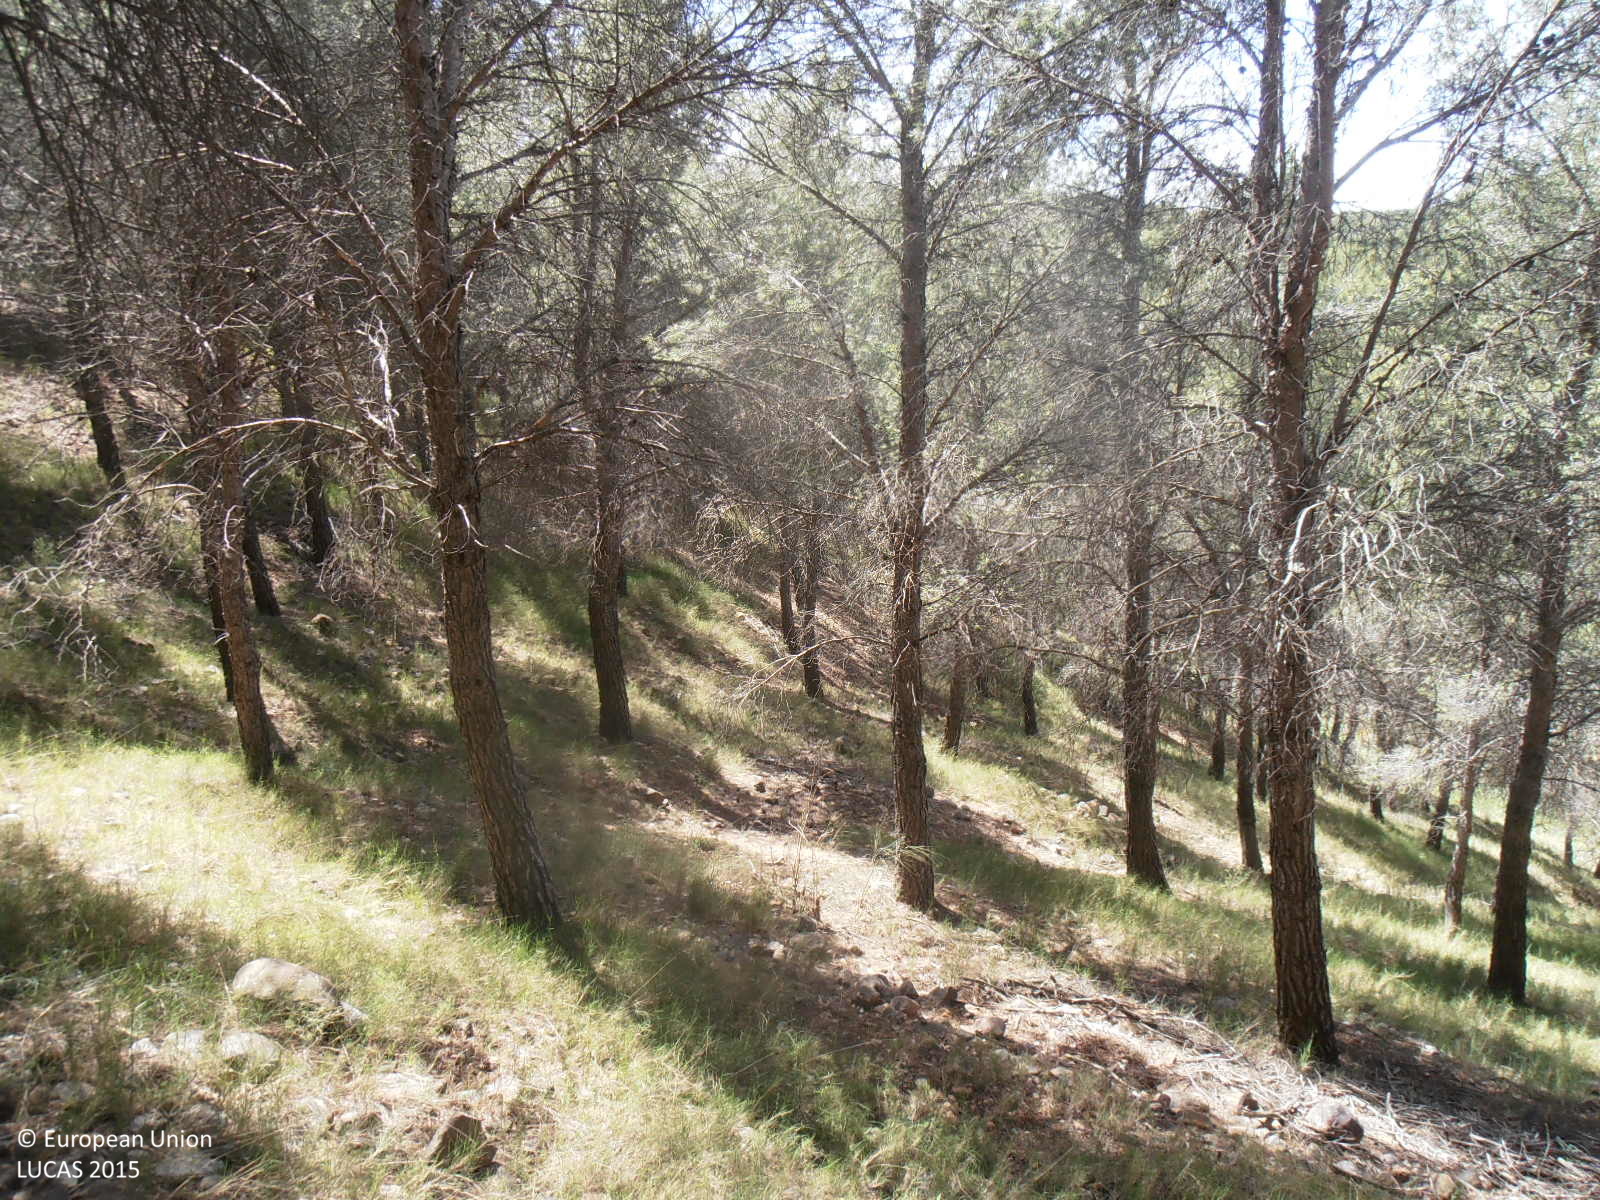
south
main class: Woodland
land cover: Pine dominated coniferous woodland
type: coniferous forest of the mediterranean region
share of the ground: > 75 %
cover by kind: coniferous forest trees 80 %, herbaceous plants 20 %
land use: Forestry
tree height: > 5 m
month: April
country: ES
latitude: 41.2404
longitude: -0.9361
